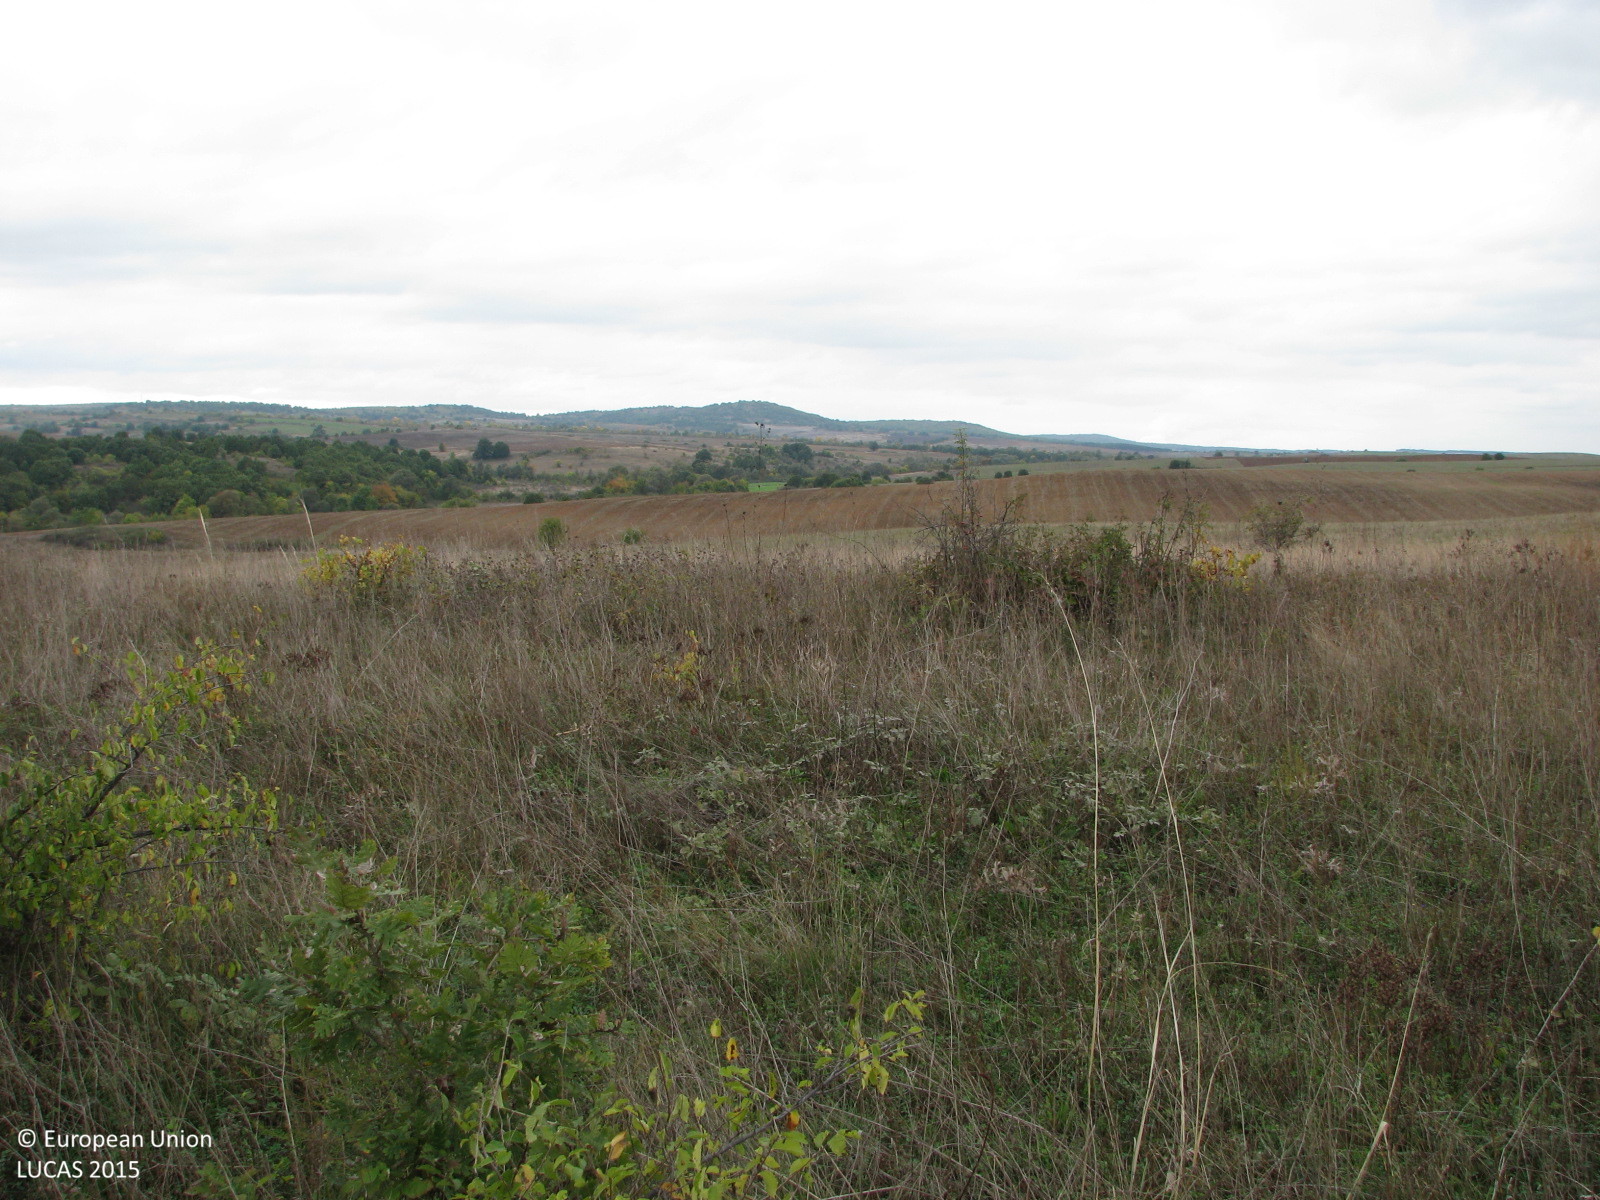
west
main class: Shrubland
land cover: Shrubland with sparse tree cover
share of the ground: 50 - 75 %
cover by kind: shrubs 60 %, herbaceous plants 35 %, broadleaved forest trees 5 %
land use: Semi-natural and natural areas not in use
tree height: < 5 m
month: October
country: BG
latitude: 42.1371
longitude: 26.3819
